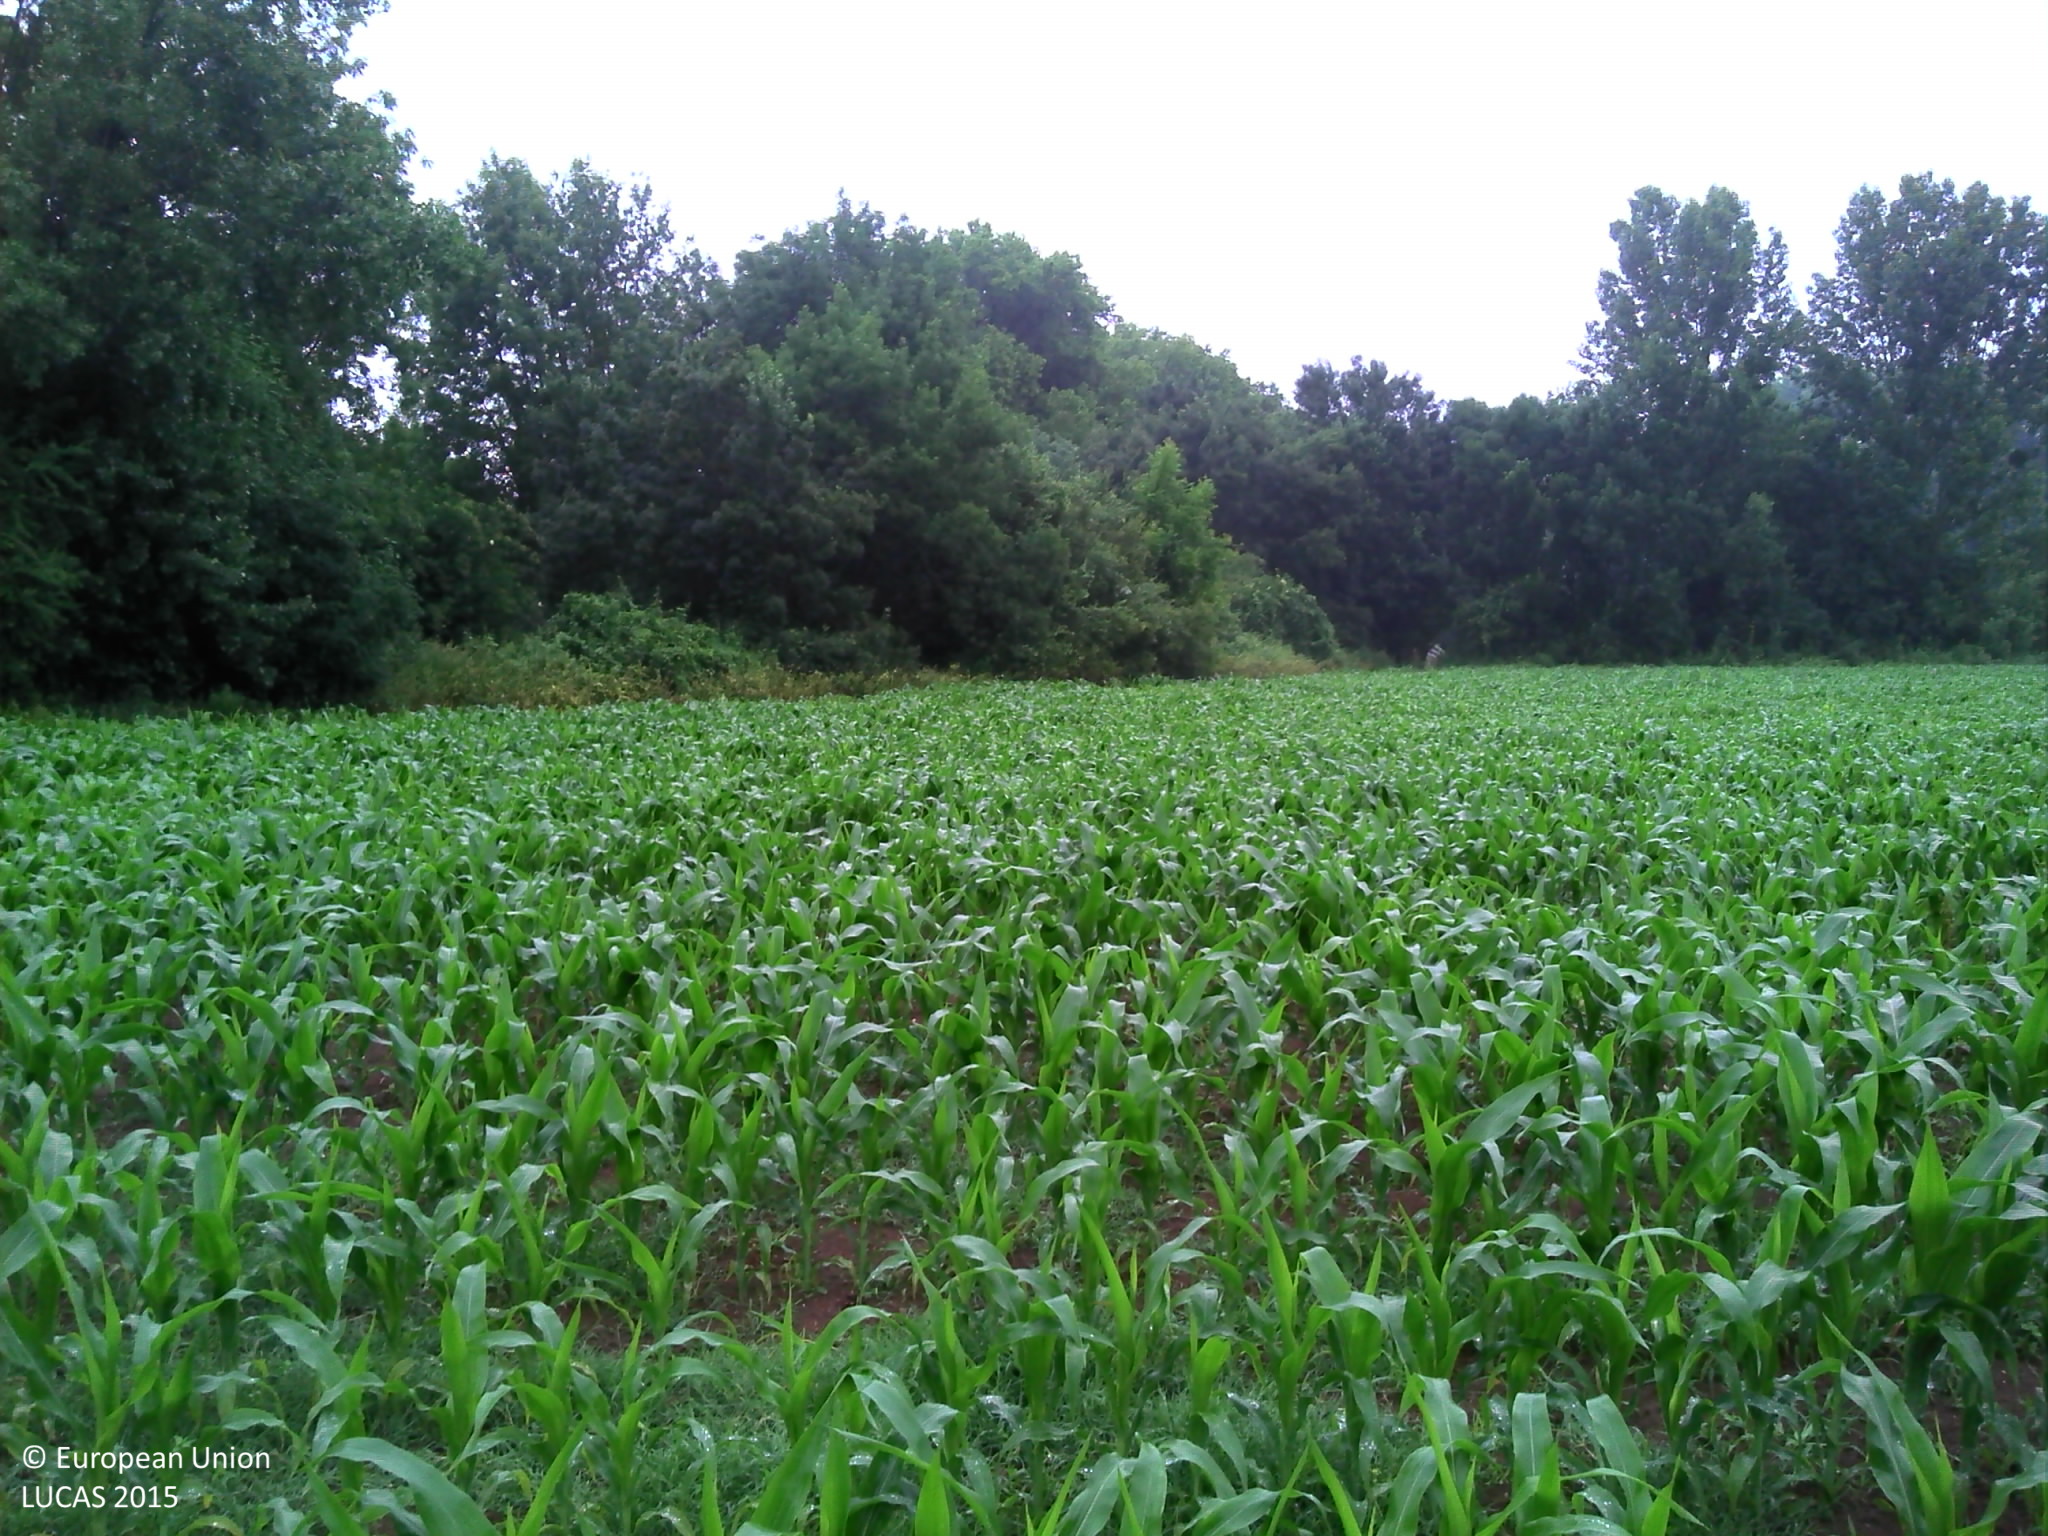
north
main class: Cropland
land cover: Maize
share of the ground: 25 - 50 %
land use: Agriculture (excluding fallow land and kitchen gardens)
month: June
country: FR
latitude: 46.7000
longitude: 0.4209
